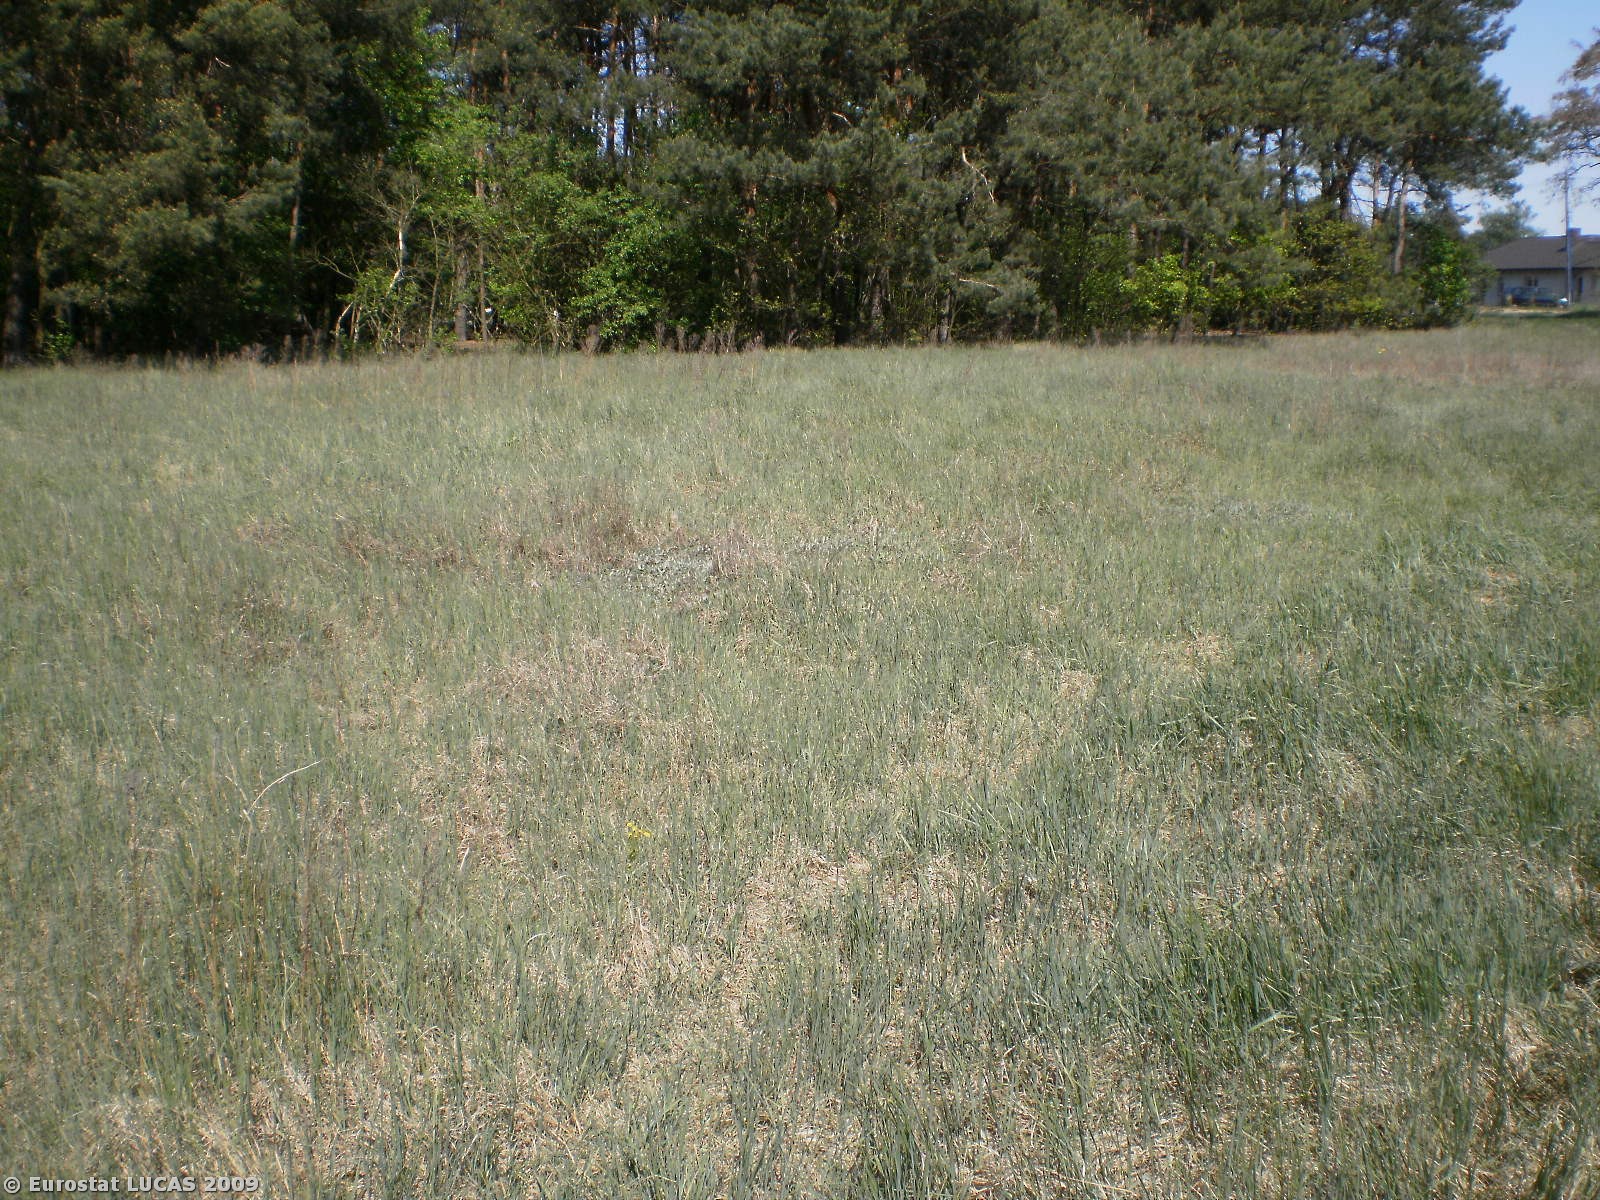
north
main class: Grassland
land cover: Grassland without tree/shrub cover
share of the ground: > 75 %
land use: Agriculture (excluding fallow land and kitchen gardens)
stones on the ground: < 10 %
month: May
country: PL
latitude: 53.4943
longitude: 18.8389
